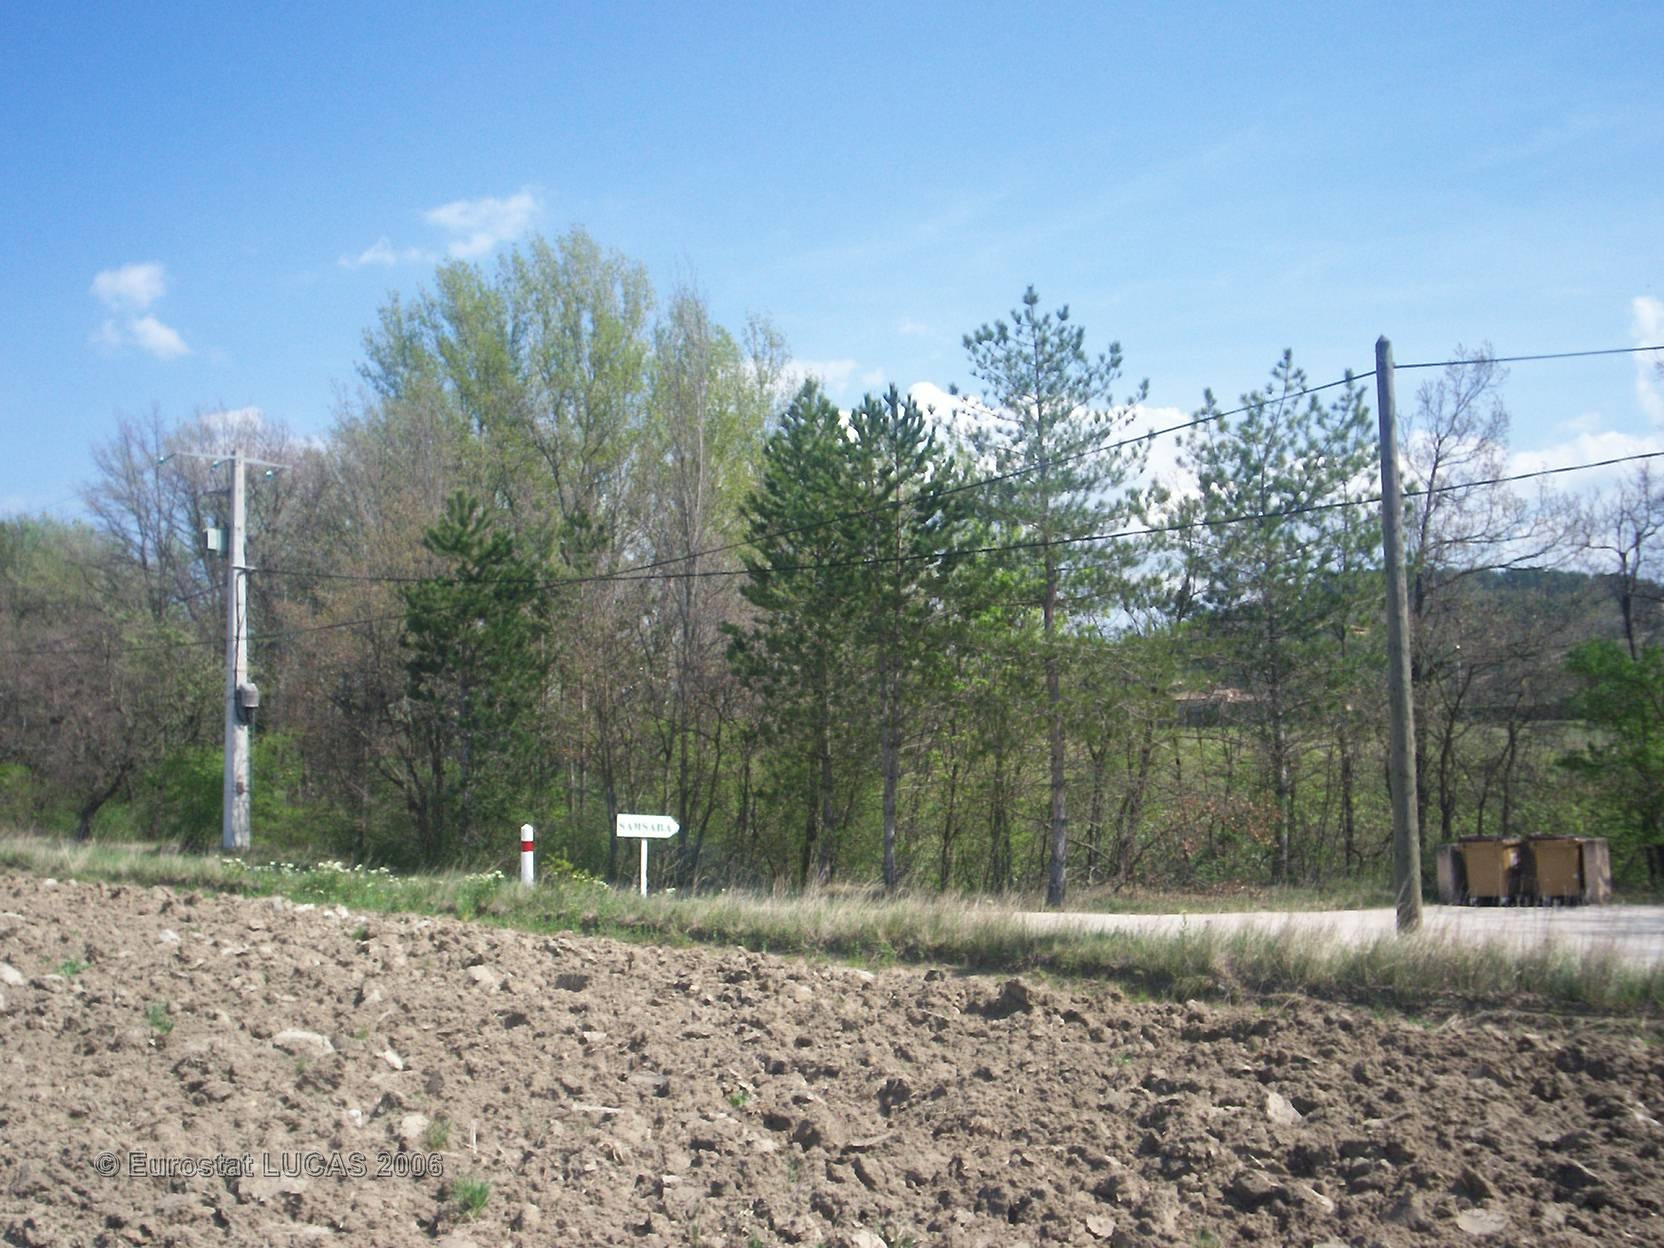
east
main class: Cropland
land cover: Other fresh vegetables
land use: Agriculture (excluding fallow land and kitchen gardens)
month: June
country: FR
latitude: 43.8992
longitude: 5.2653
